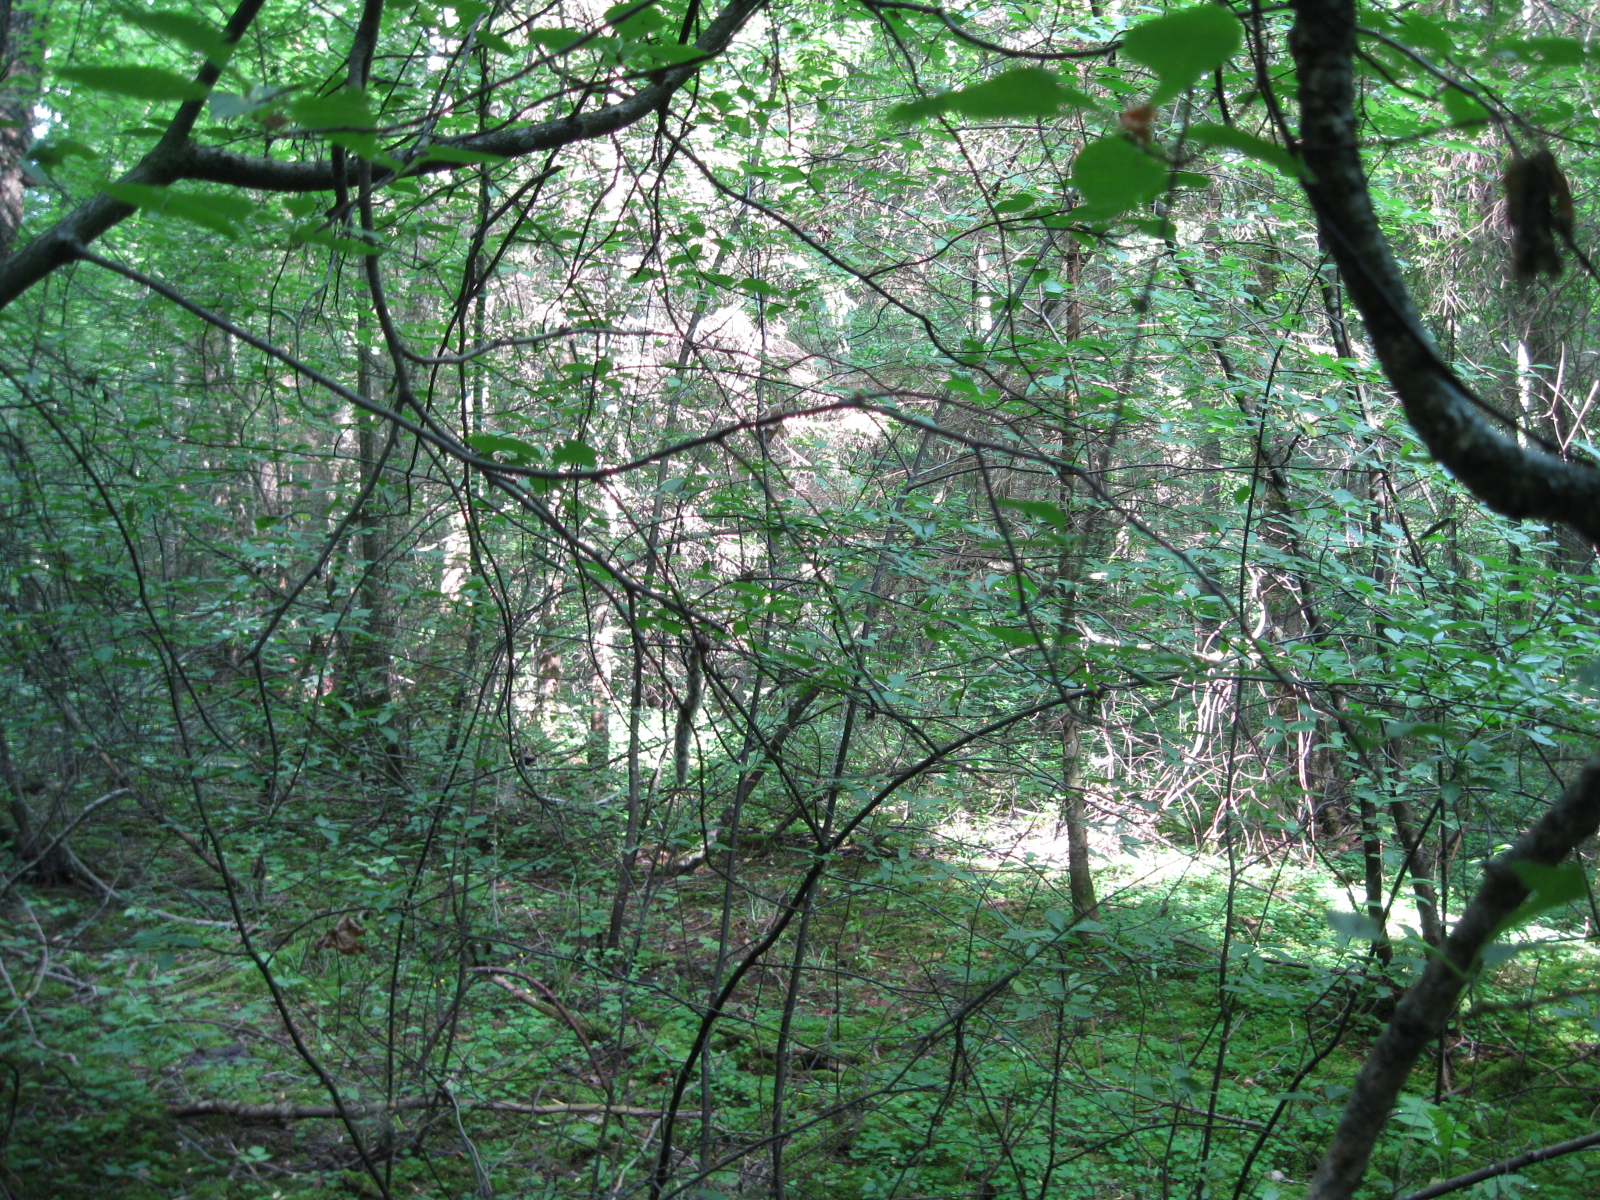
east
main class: Woodland
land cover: Spruce dominated mixed woodland
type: hemiboreal forest and nemoral coniferous forest and mixed broadleaved-coniferous forest
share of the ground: > 75 %
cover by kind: coniferous forest trees 45 %, broadleaved forest trees 40 %, shrubs 5 %, herbaceous plants 5 %, lichens and mosses 5 %
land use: Forestry
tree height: > 5 m
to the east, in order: Spruce dominated mixed woodland; Broadleaved woodland
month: June
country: LT
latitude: 55.5968
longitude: 23.8446
